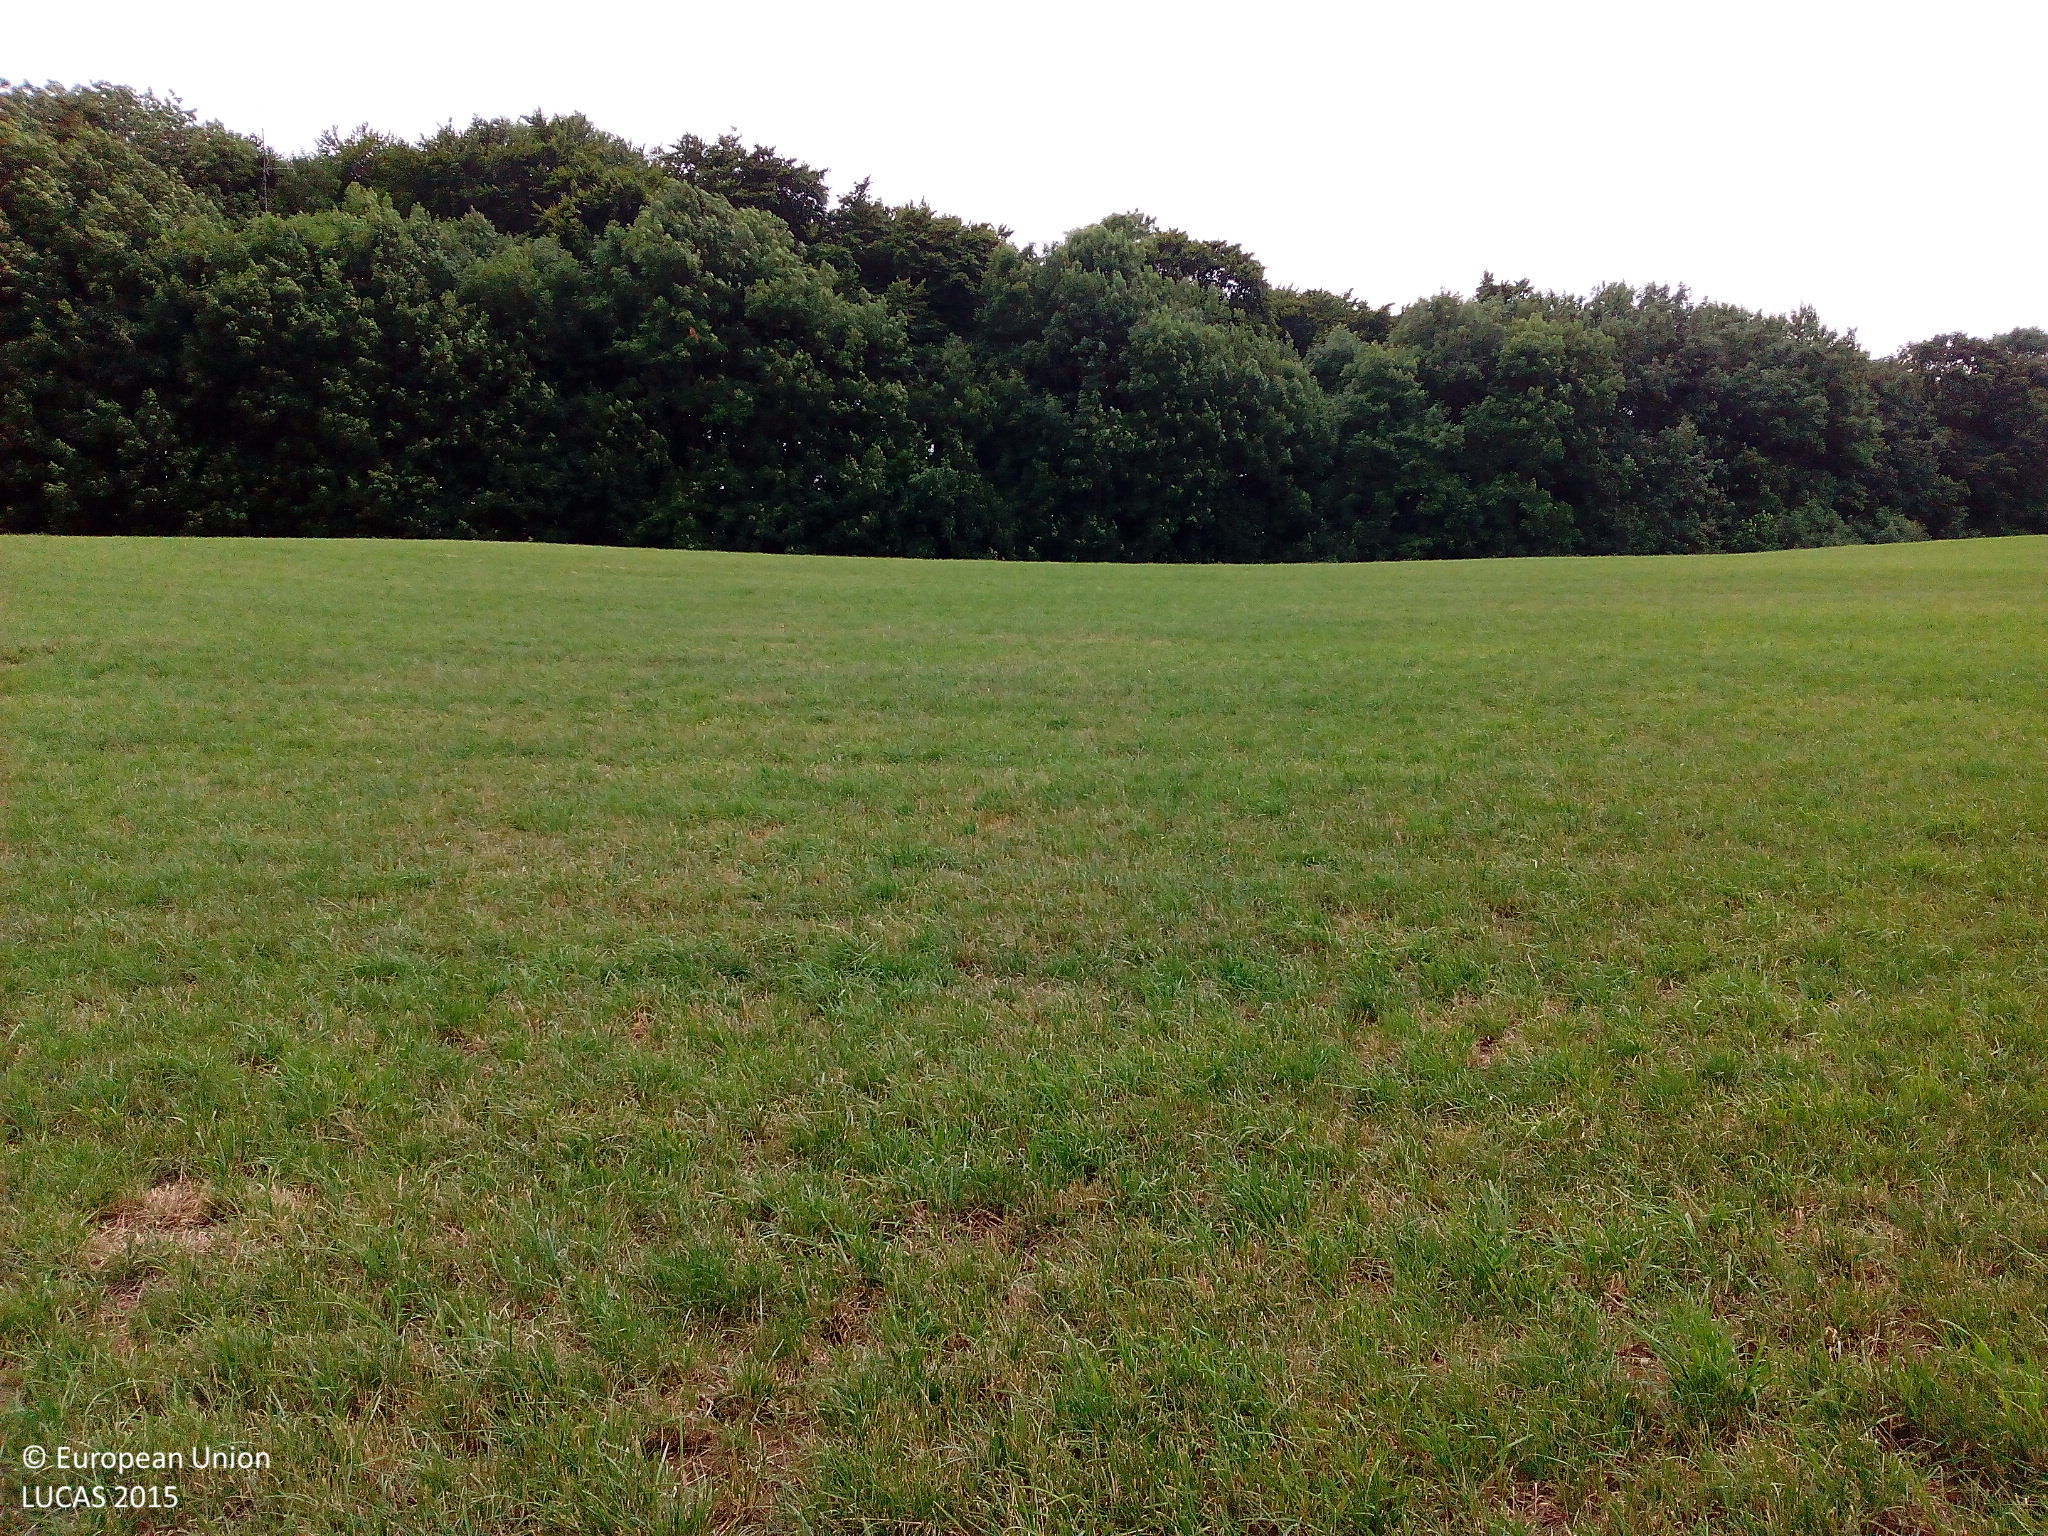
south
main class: Grassland
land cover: Grassland without tree/shrub cover
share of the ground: > 75 %
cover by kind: herbaceous plants 100 %
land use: Agriculture (excluding fallow land and kitchen gardens)
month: July
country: DE
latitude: 50.8135
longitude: 9.9007
